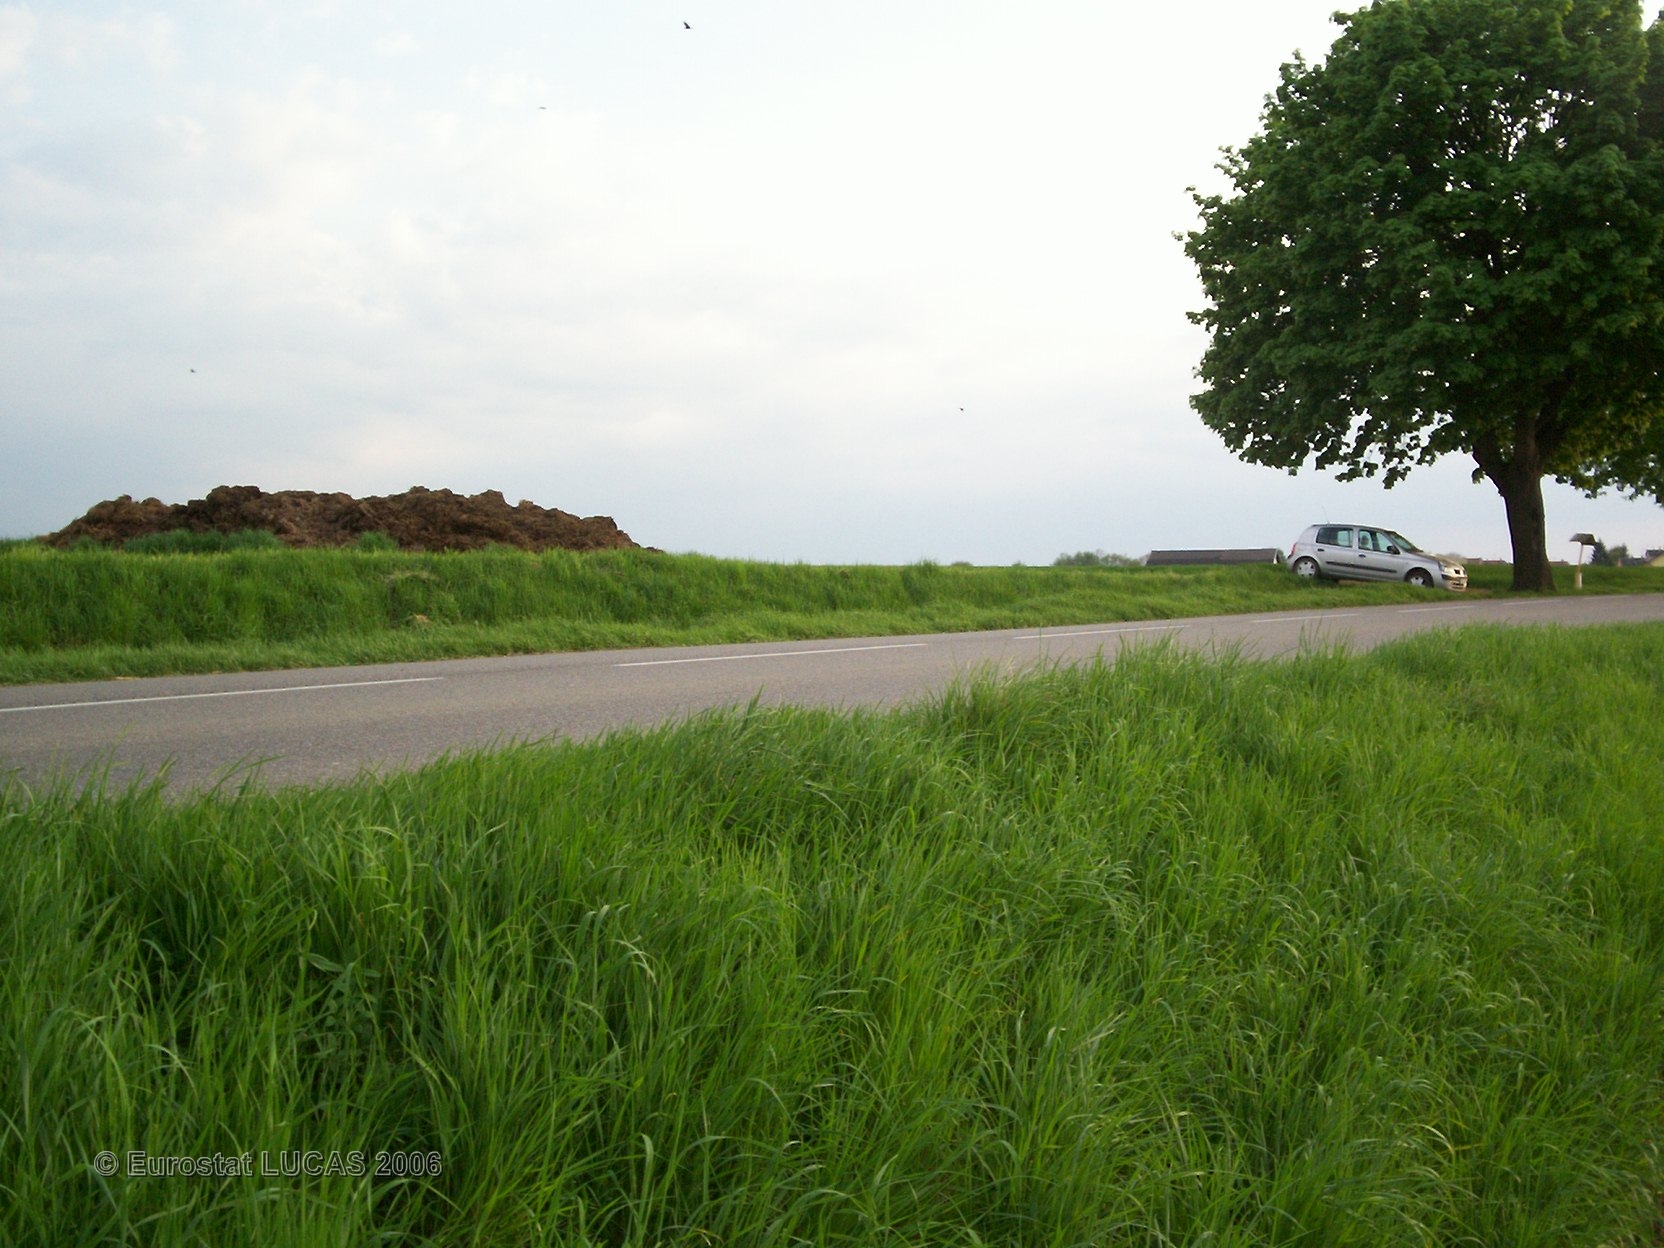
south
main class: Cropland
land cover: Maize
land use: Agriculture (excluding fallow land and kitchen gardens)
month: May
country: FR
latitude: 47.6462
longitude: 7.1395
